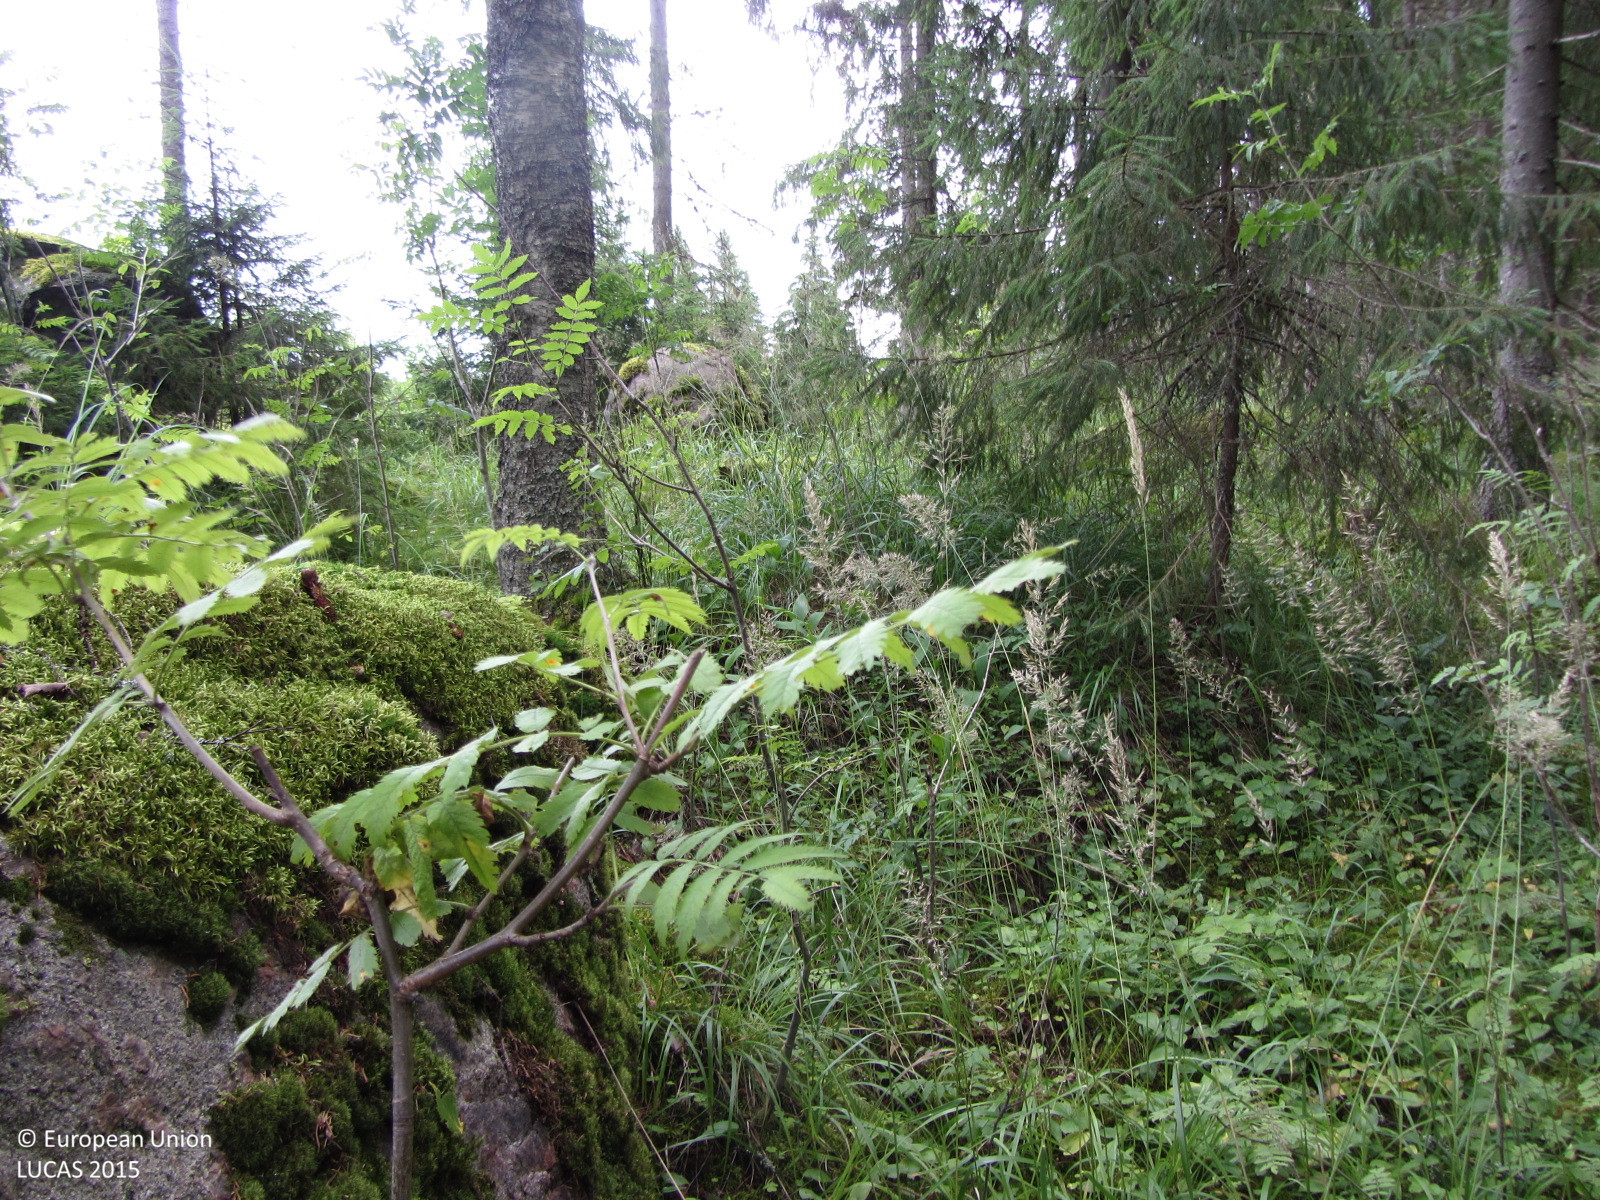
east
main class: Woodland
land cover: Spruce dominated coniferous woodland
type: boreal forest
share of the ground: > 75 %
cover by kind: coniferous forest trees 80 %, herbaceous plants 15 %, broadleaved forest trees 5 %
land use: Forestry
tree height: > 5 m
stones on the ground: 10 - 25 %
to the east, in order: Spruce dominated coniferous woodland; Broadleaved woodland; Spruce dominated mixed woodland; Ditches and canals; Oats; Ditches and canals; Grass margins; Spruce dominated coniferous woodland
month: August
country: FI
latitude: 60.6932
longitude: 24.6686
